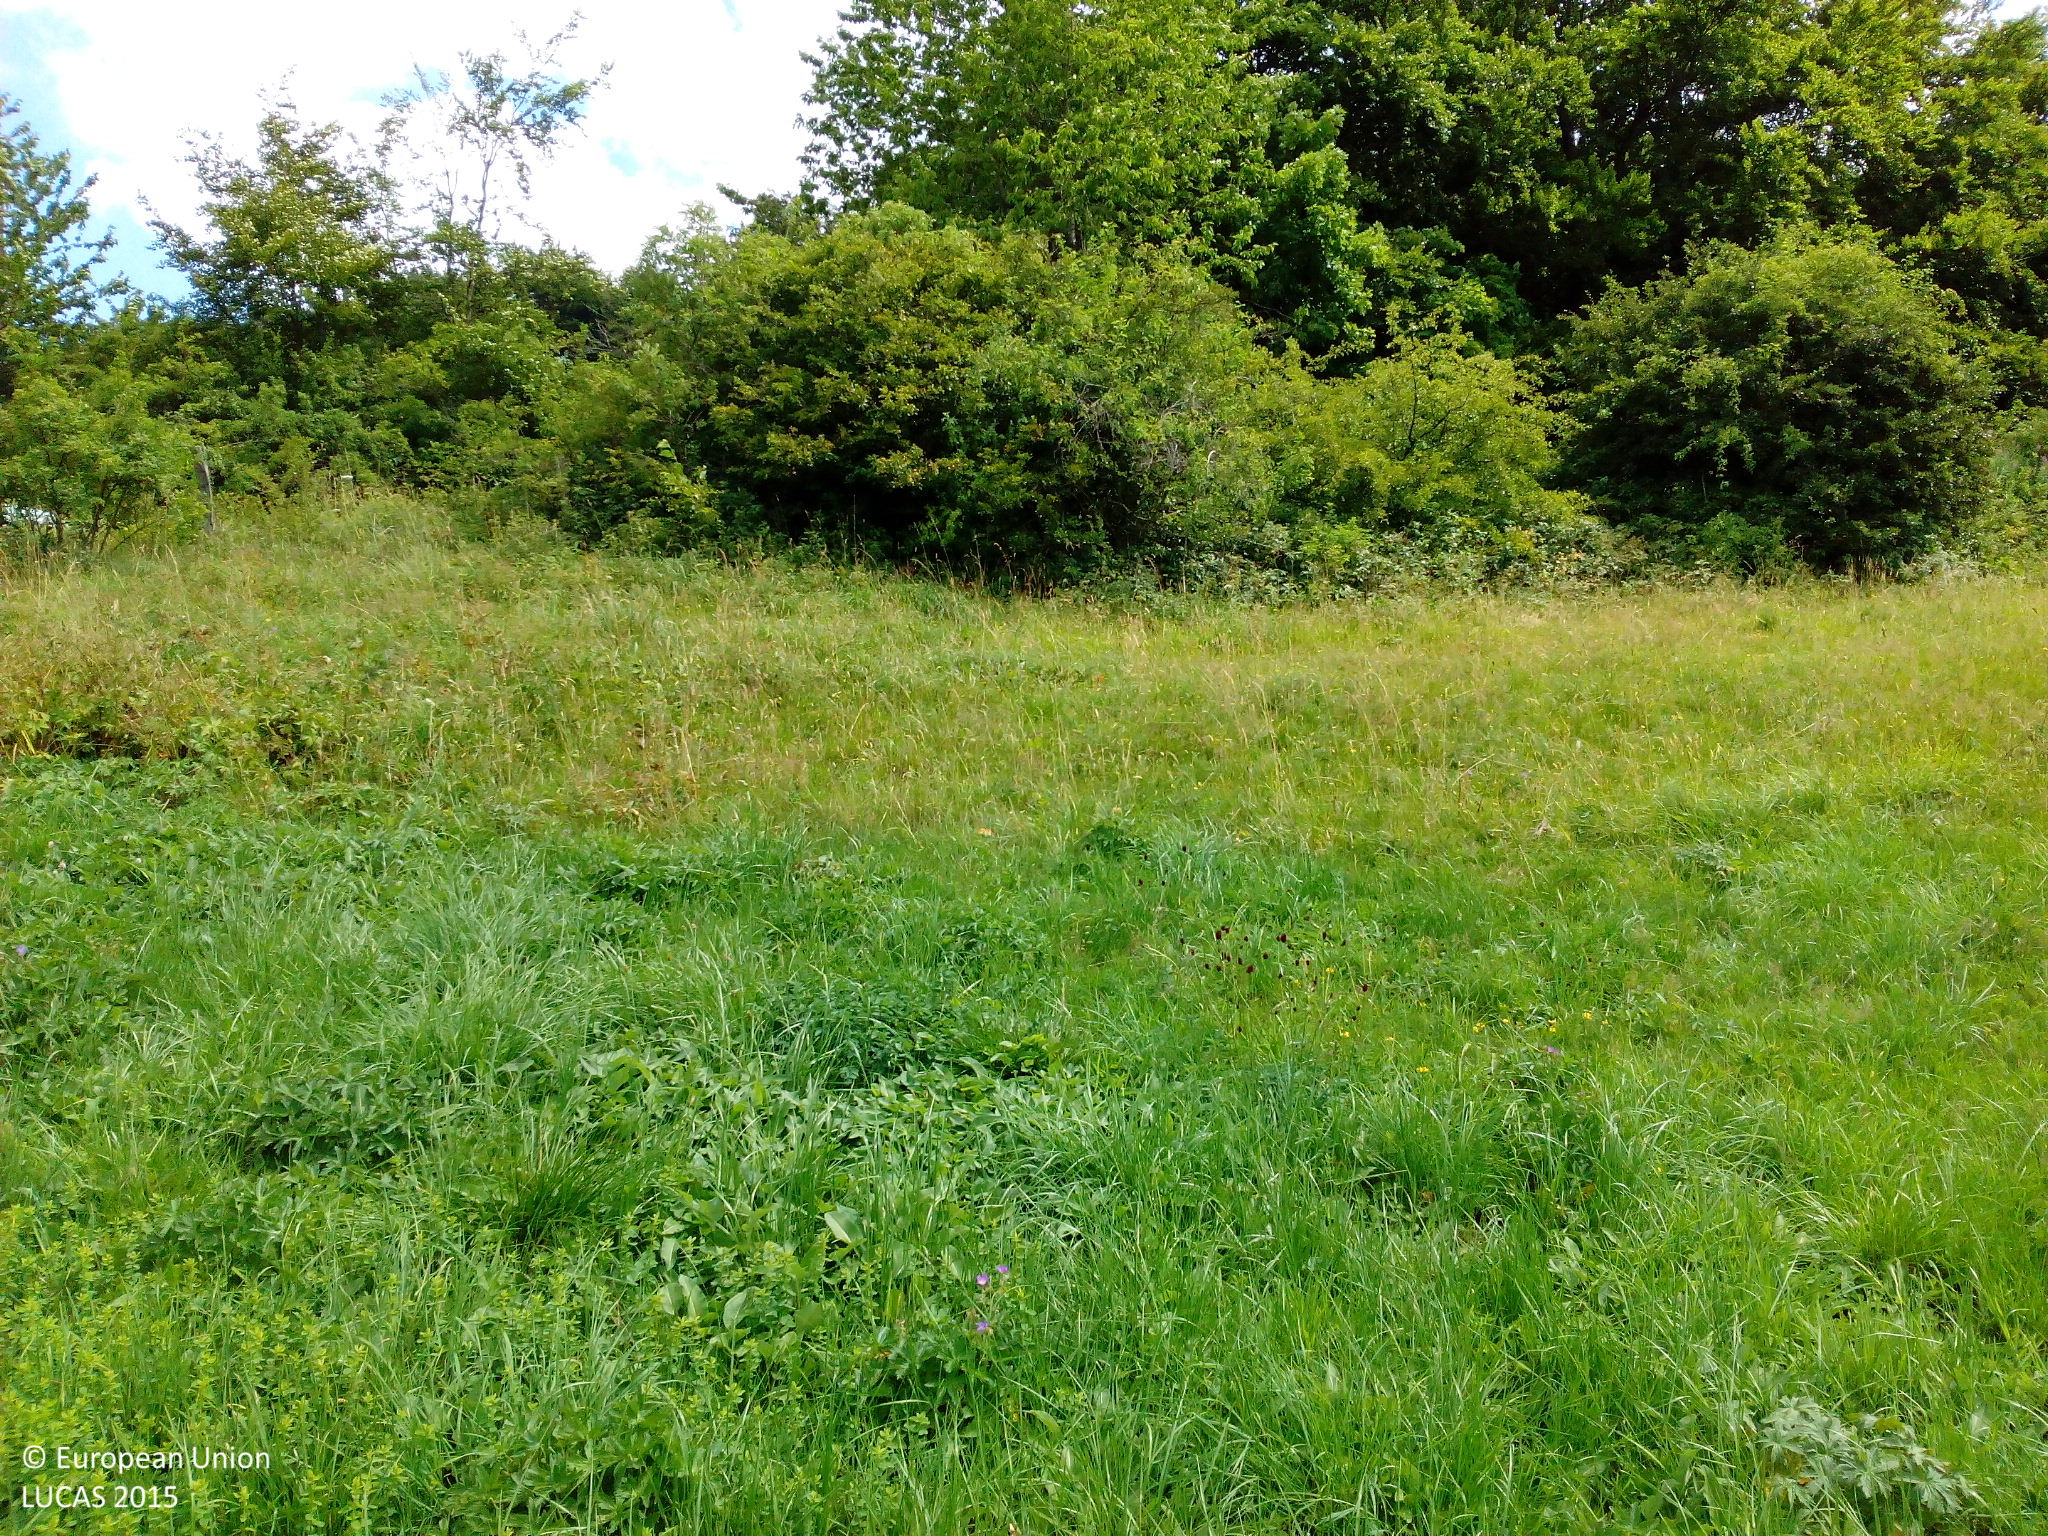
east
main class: Grassland
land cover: Grassland without tree/shrub cover
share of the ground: > 75 %
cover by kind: herbaceous plants 100 %
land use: Agriculture (excluding fallow land and kitchen gardens)
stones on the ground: < 10 %
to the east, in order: Grassland without tree/shrub cover; Fences; Grassland without tree/shrub cover; Tracks; Grass margins; Ditches and canals; Grass margins; Fences; Shrubland with sparse tree cover; Grassland without tree/shrub cover; Grassland with sparse tree/shrub cover; Broadleaved woodland; Grassland with sparse tree/shrub cover; Fences; Grassland without tree/shrub cover
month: July
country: DE
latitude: 50.4360
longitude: 9.9578
